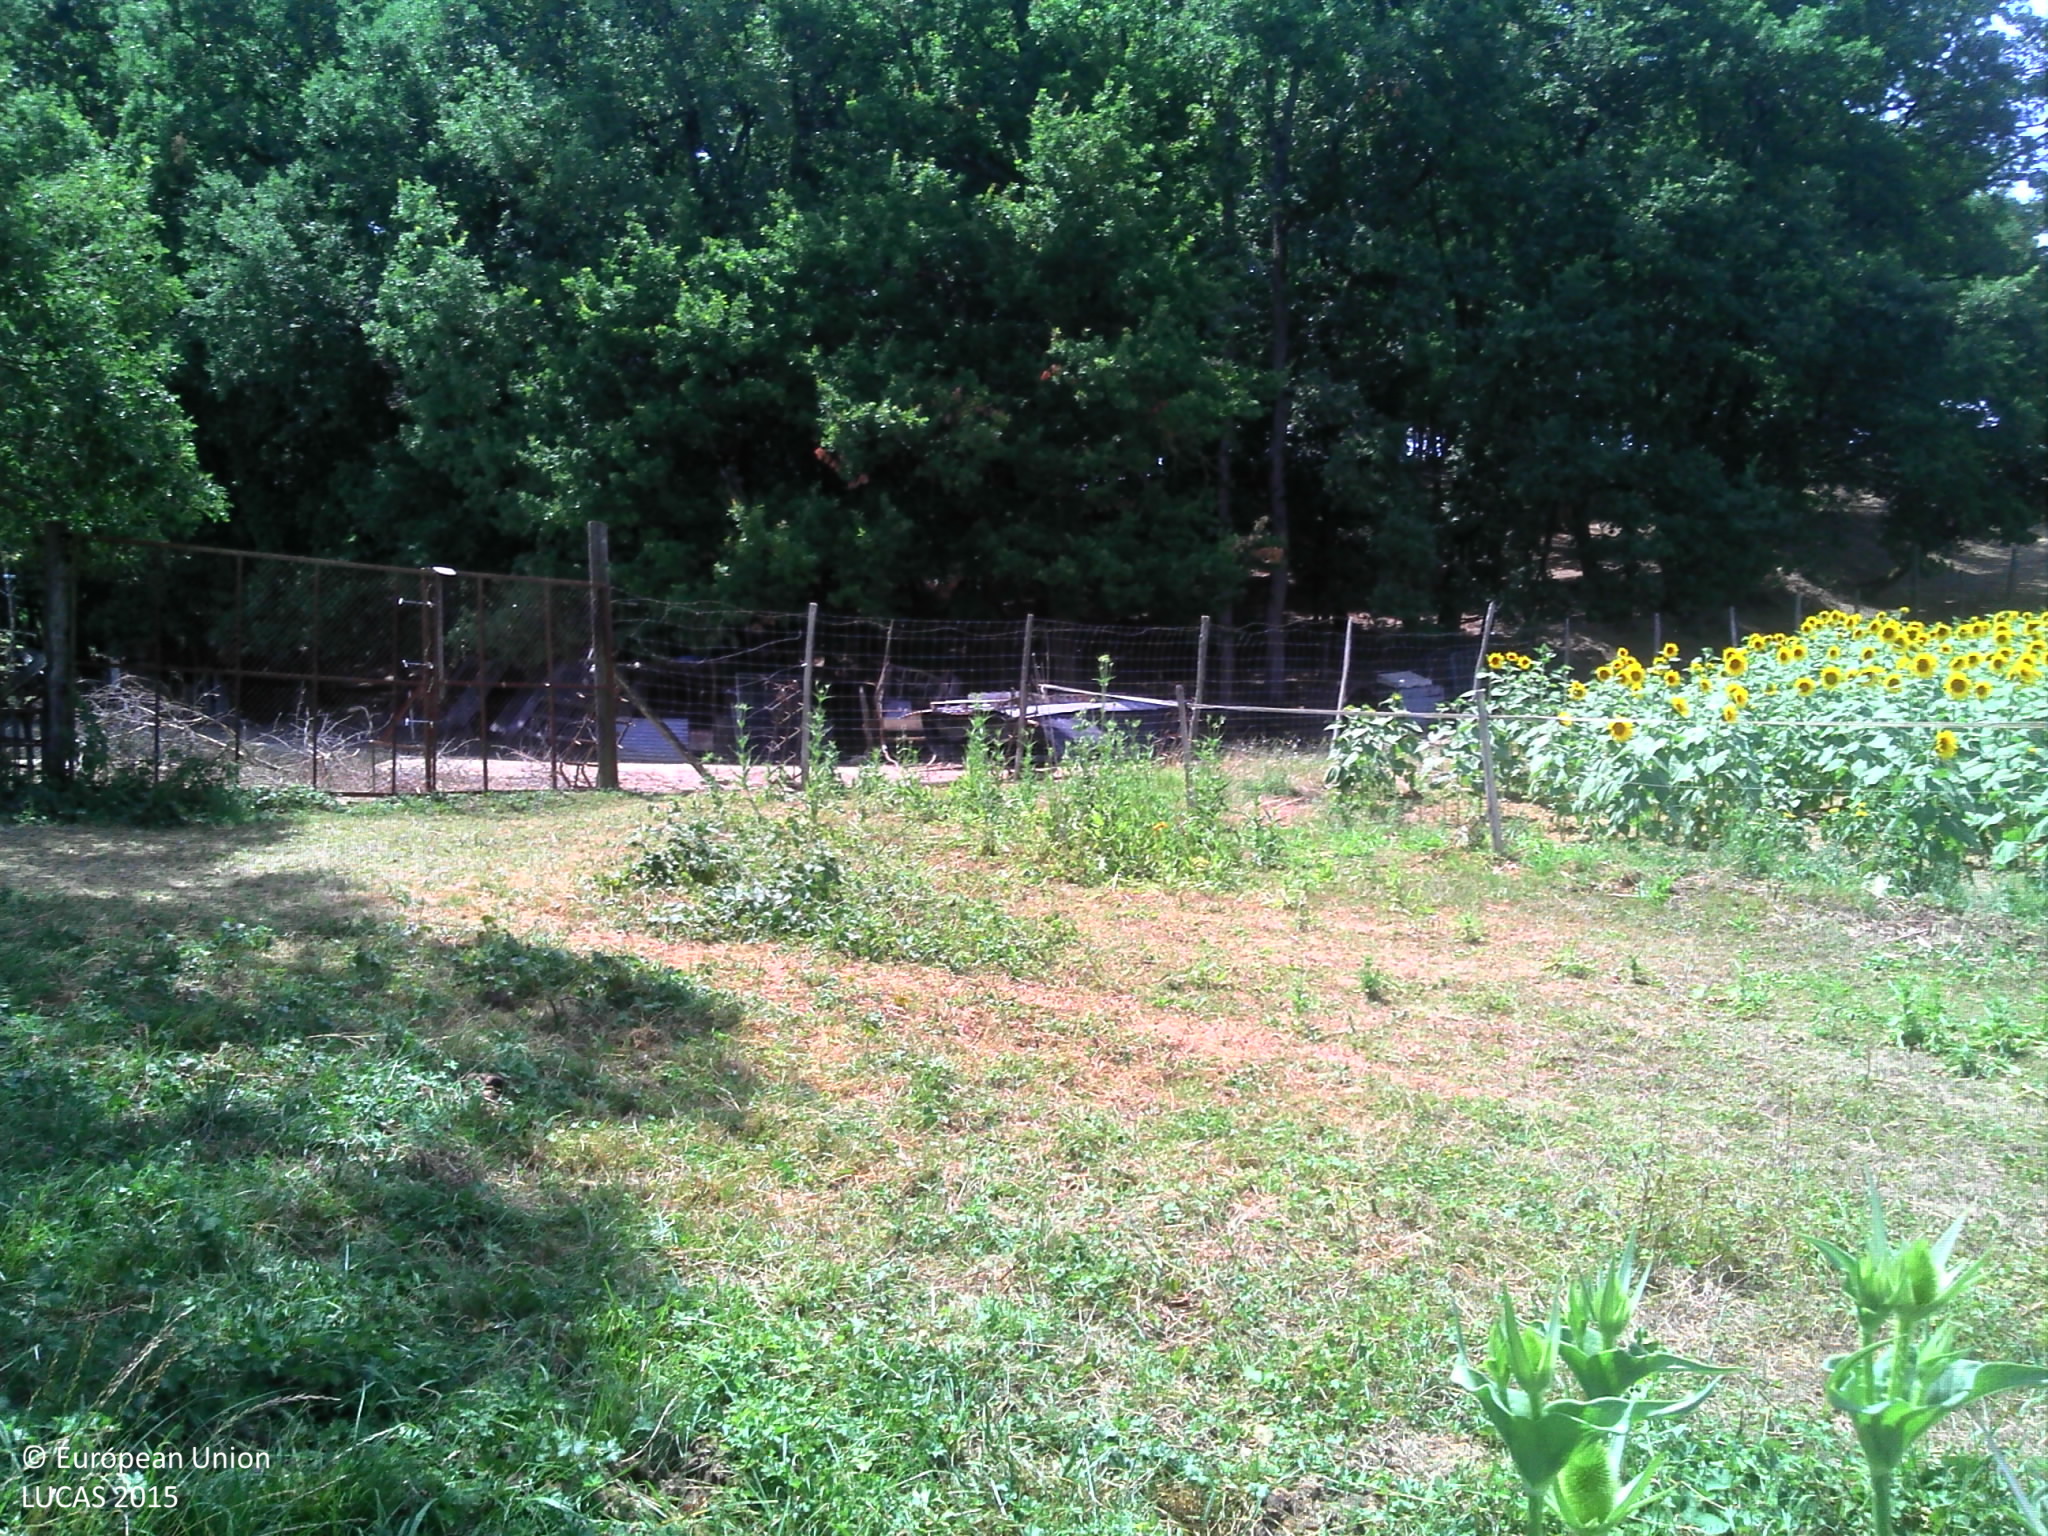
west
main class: Grassland
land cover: Grassland without tree/shrub cover
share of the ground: > 75 %
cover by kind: herbaceous plants 95 %, shrubs 5 %
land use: Agriculture (excluding fallow land and kitchen gardens)
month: July
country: FR
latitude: 43.7214
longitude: 1.6240
